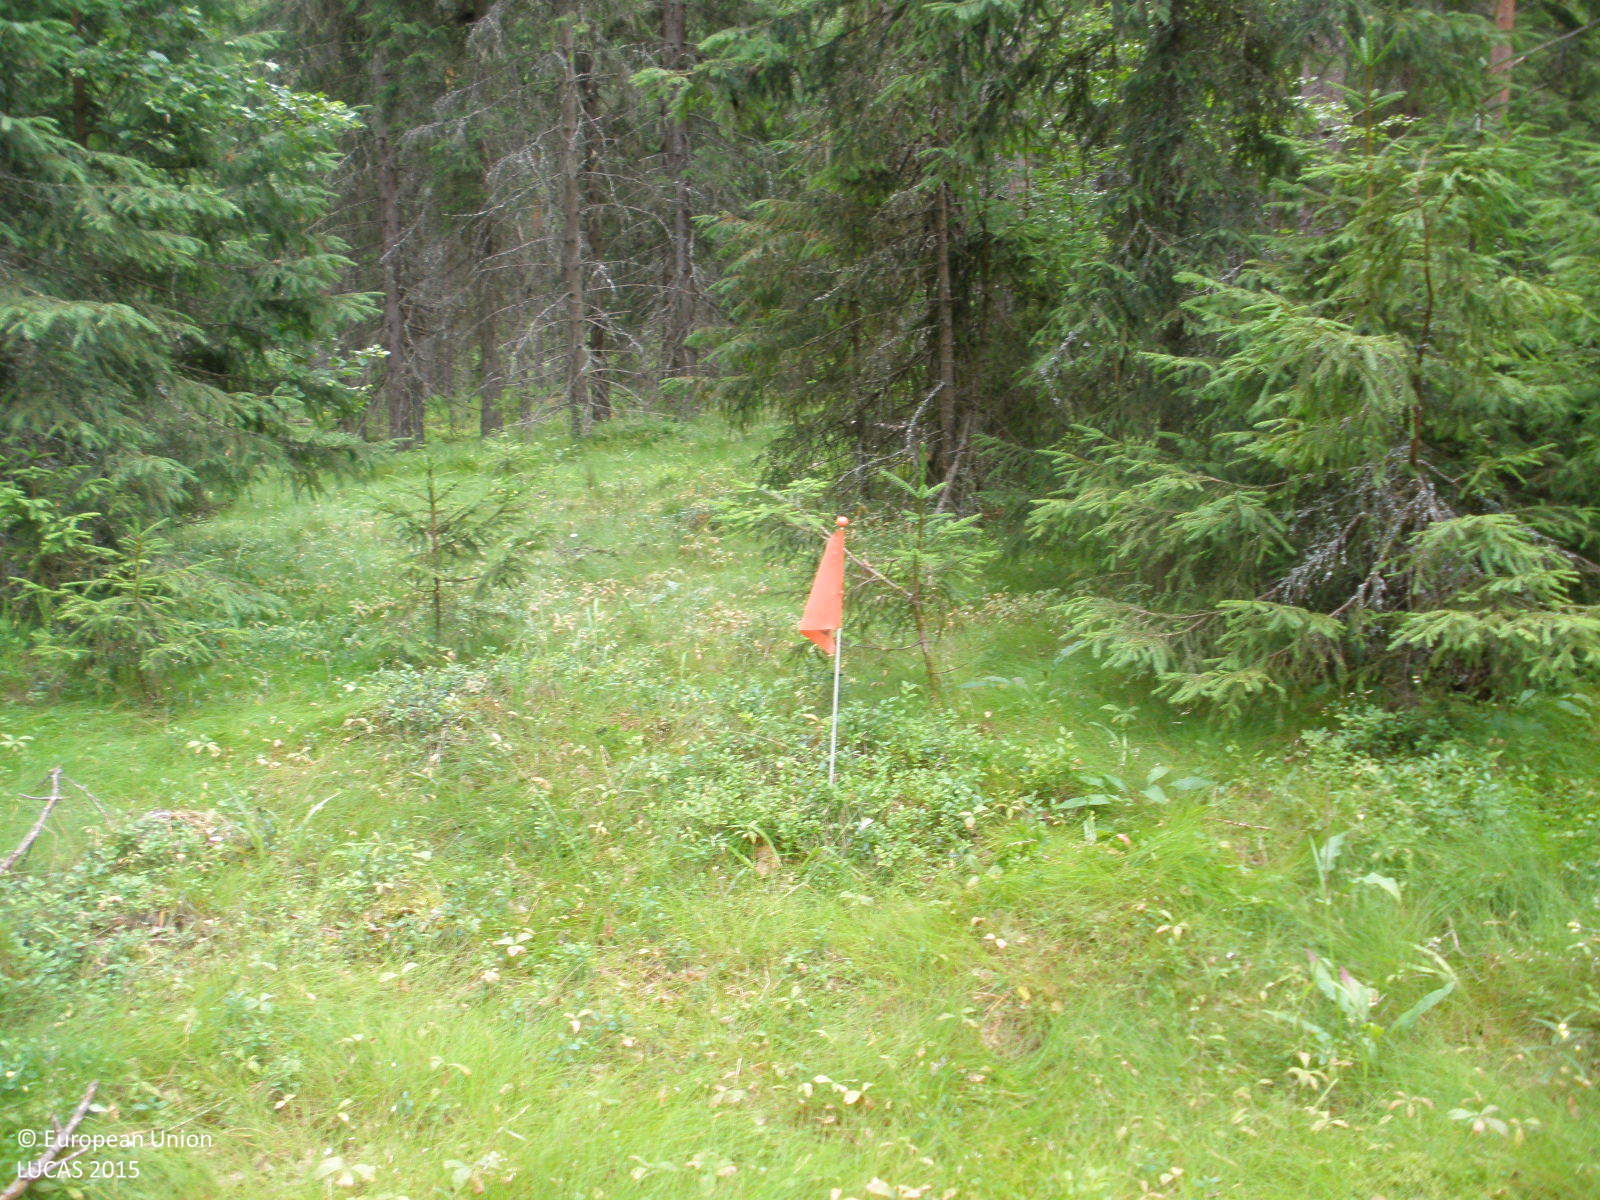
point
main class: Woodland
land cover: Pine dominated coniferous woodland
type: boreal forest
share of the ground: > 75 %
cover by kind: coniferous forest trees 75 %, herbaceous plants 10 %, lichens and mosses 10 %, broadleaved forest trees 5 %
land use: Forestry
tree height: > 5 m
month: July
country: FI
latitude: 61.4186
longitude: 24.5853
